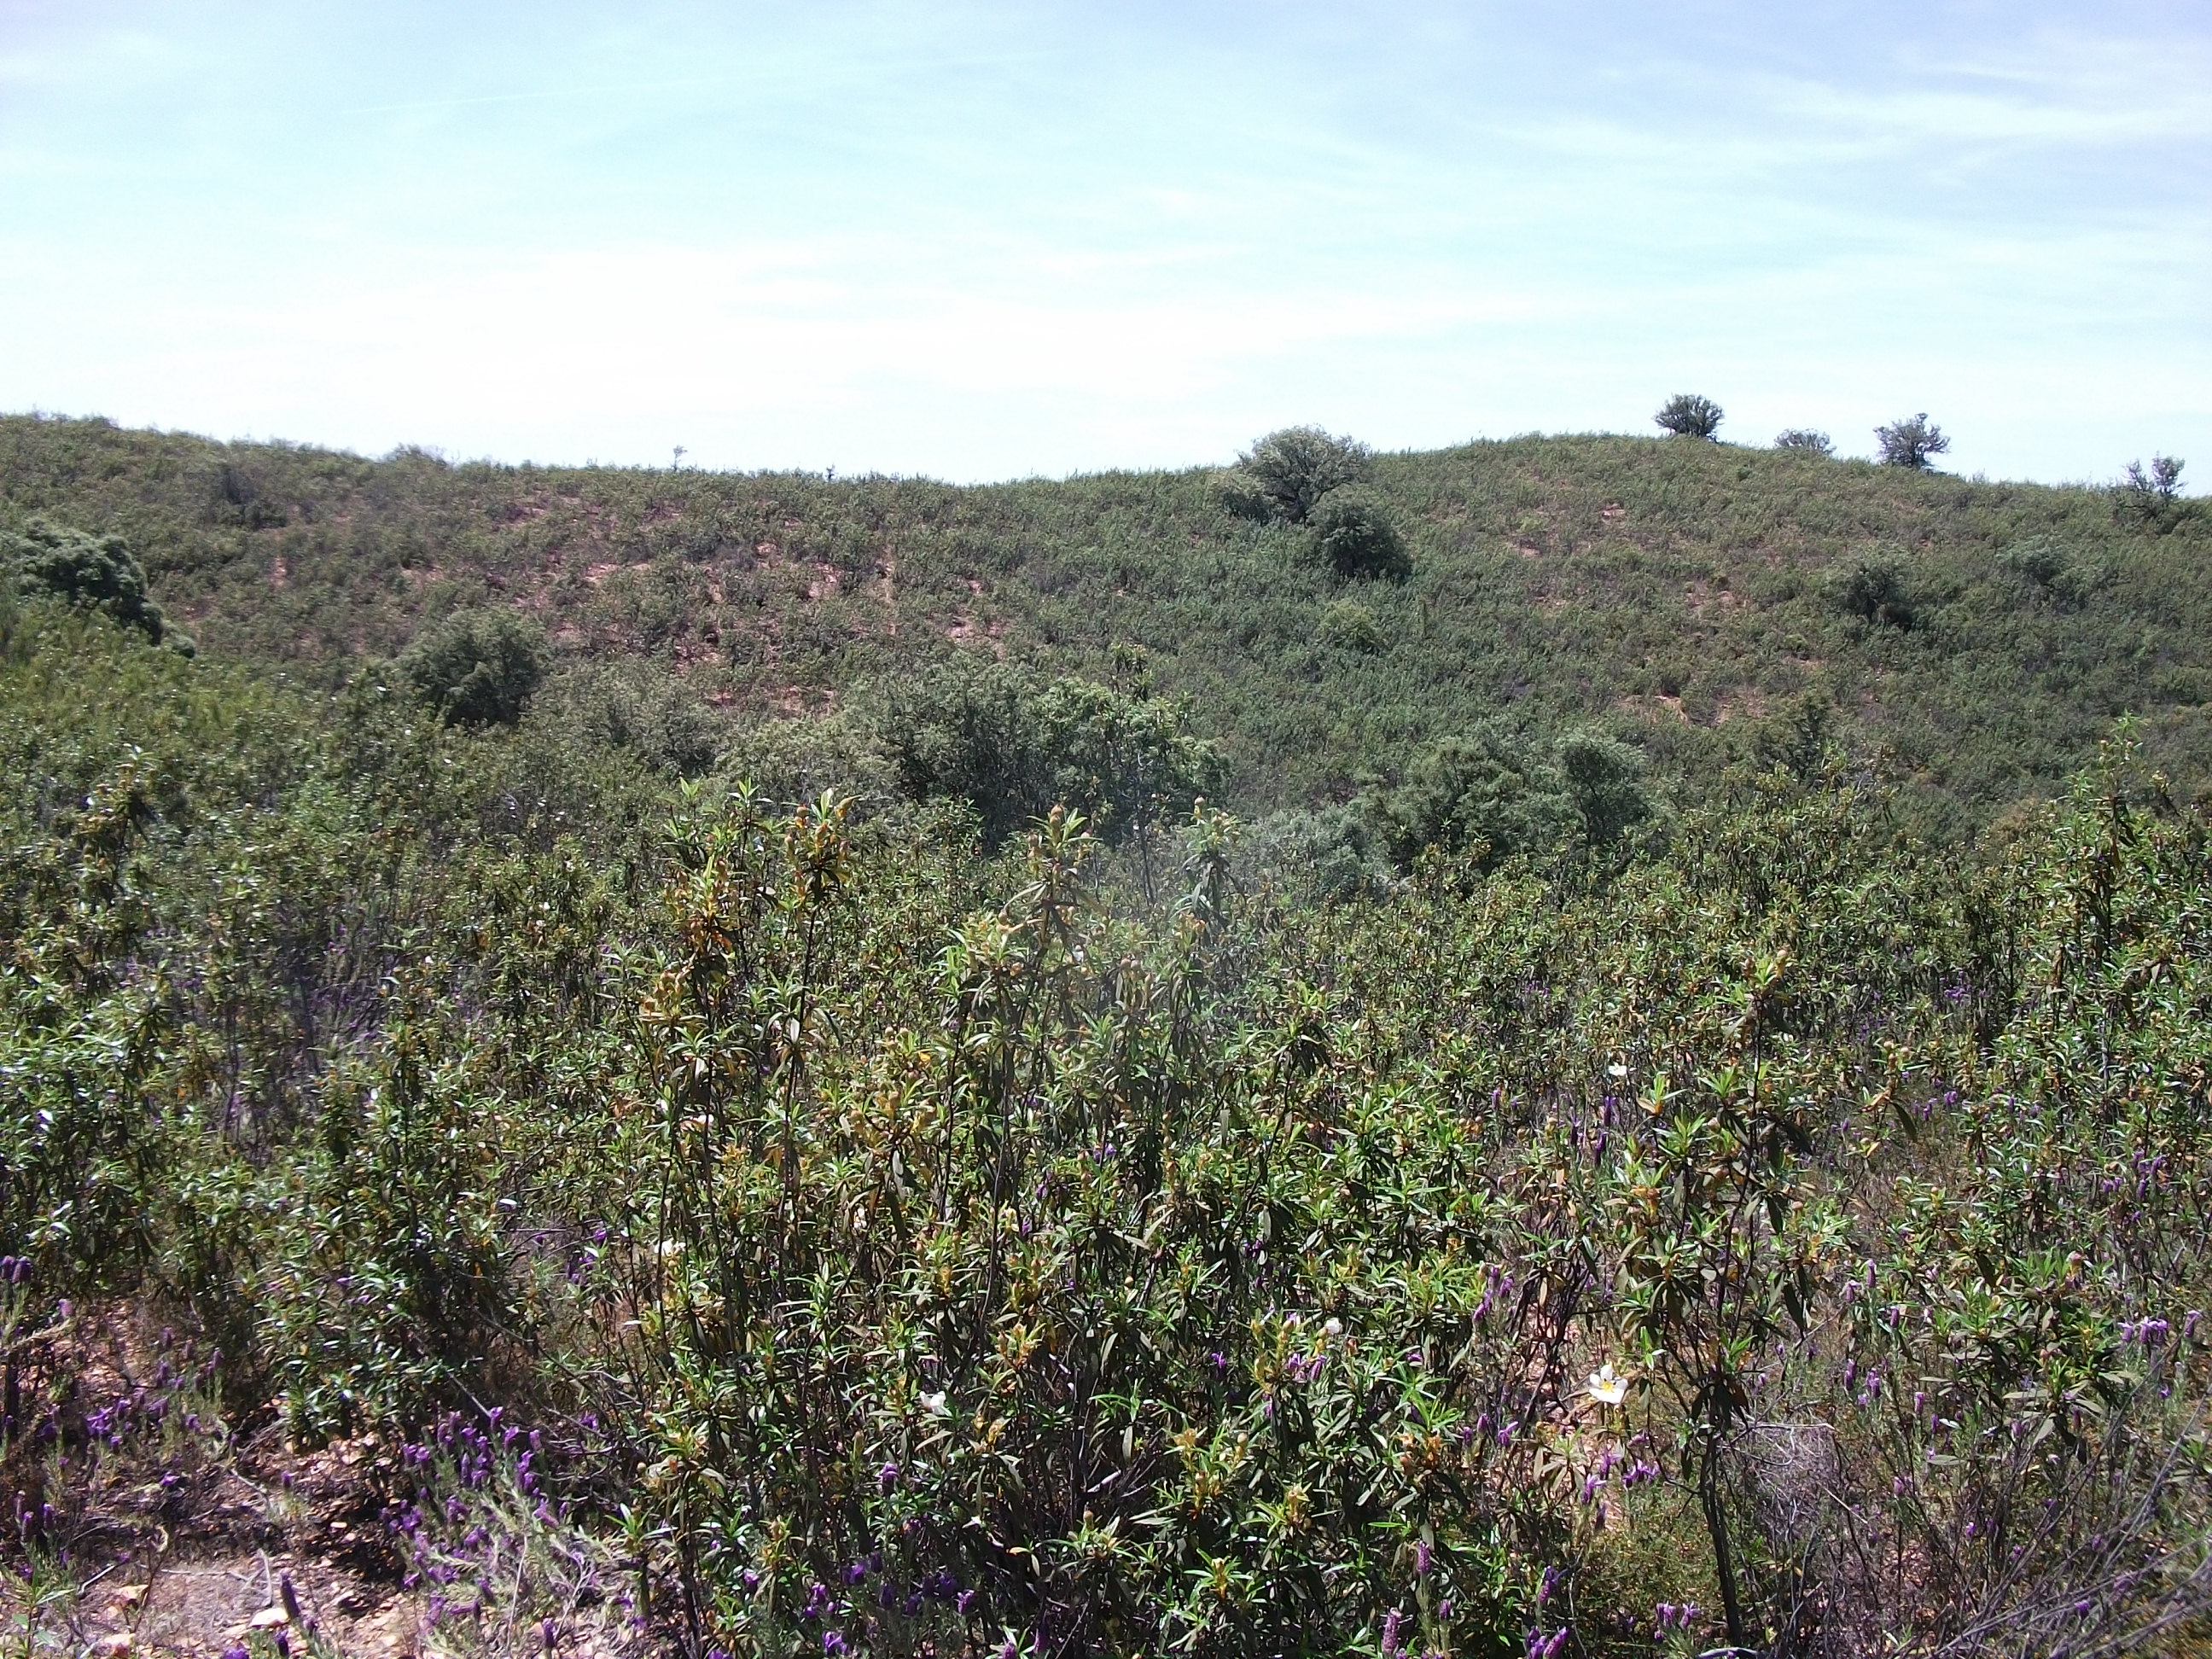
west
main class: Woodland
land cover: Broadleaved woodland
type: broadleaved evergreen forest
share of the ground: 10 - 25 %
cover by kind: shrubs 90 %, broadleaved forest trees 10 %
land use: Forestry
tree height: < 5 m
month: May
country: ES
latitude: 37.8484
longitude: -7.2044
